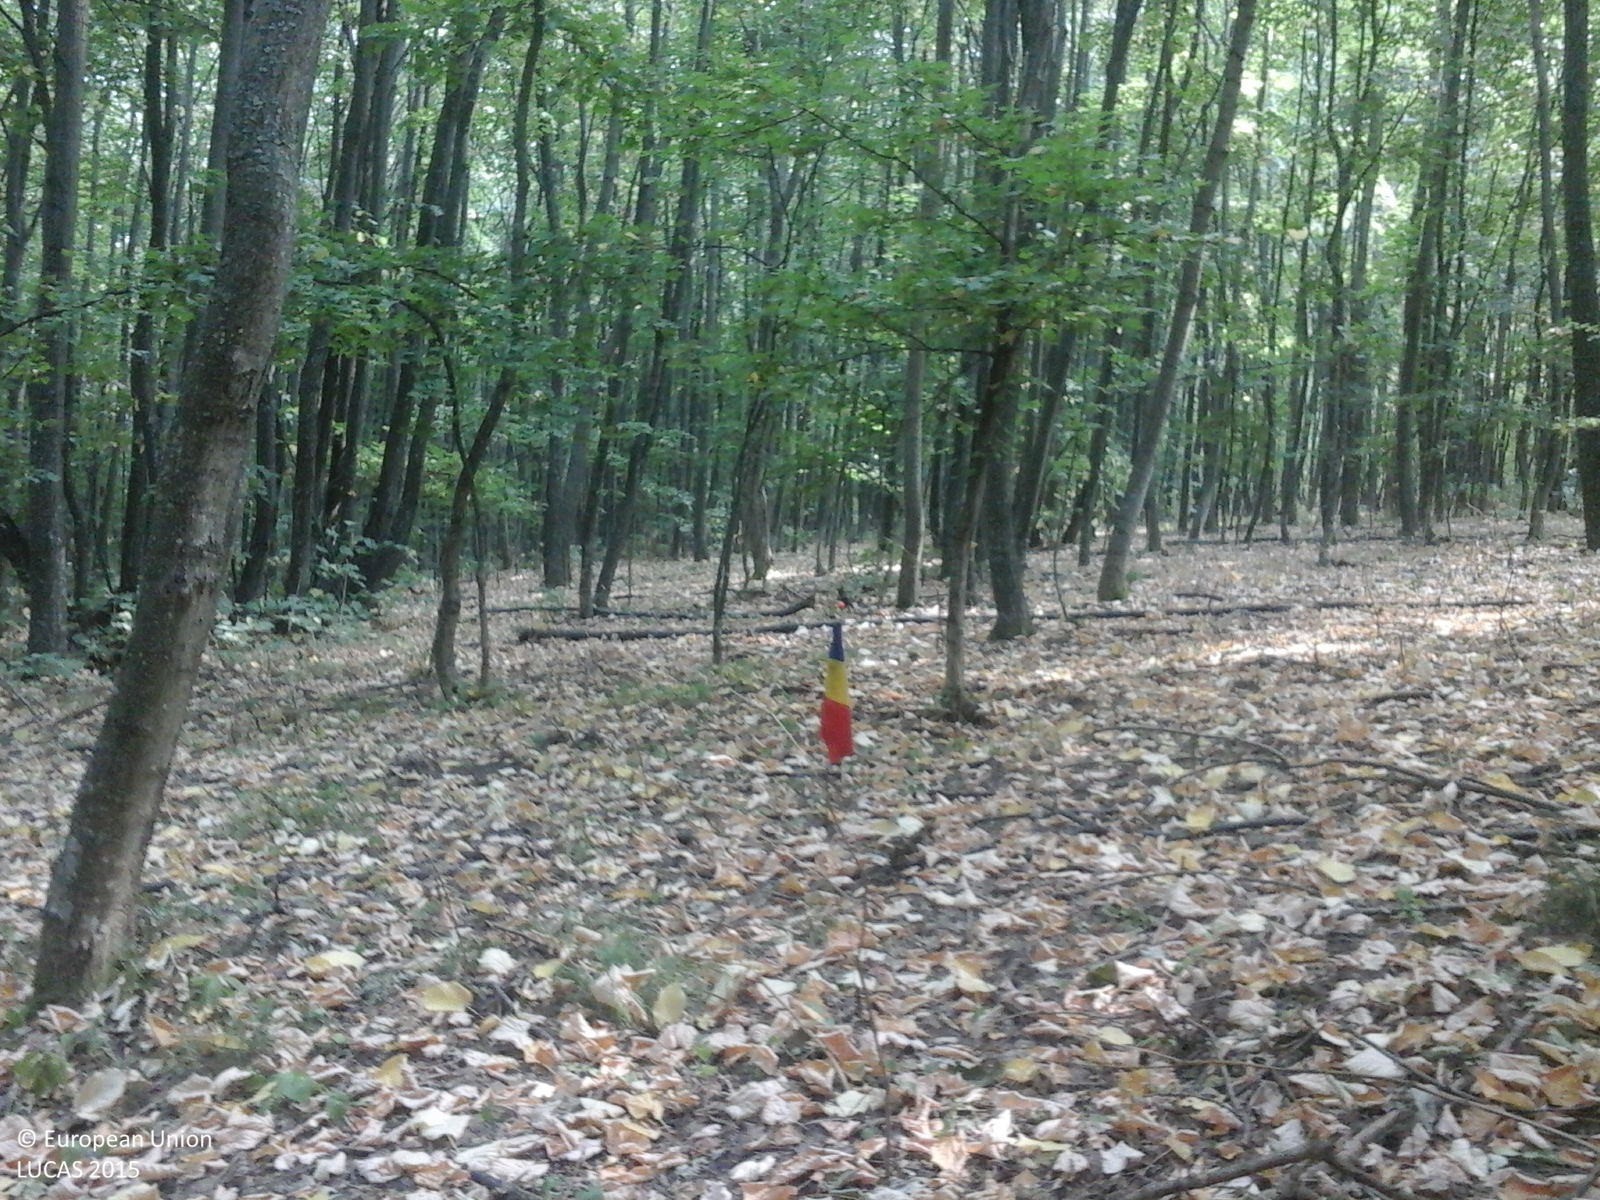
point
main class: Woodland
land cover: Broadleaved woodland
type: mesophytic deciduous forest
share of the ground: > 75 %
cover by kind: broadleaved forest trees 100 %
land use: Forestry
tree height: > 5 m
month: July
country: RO
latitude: 45.1423
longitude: 28.5072
